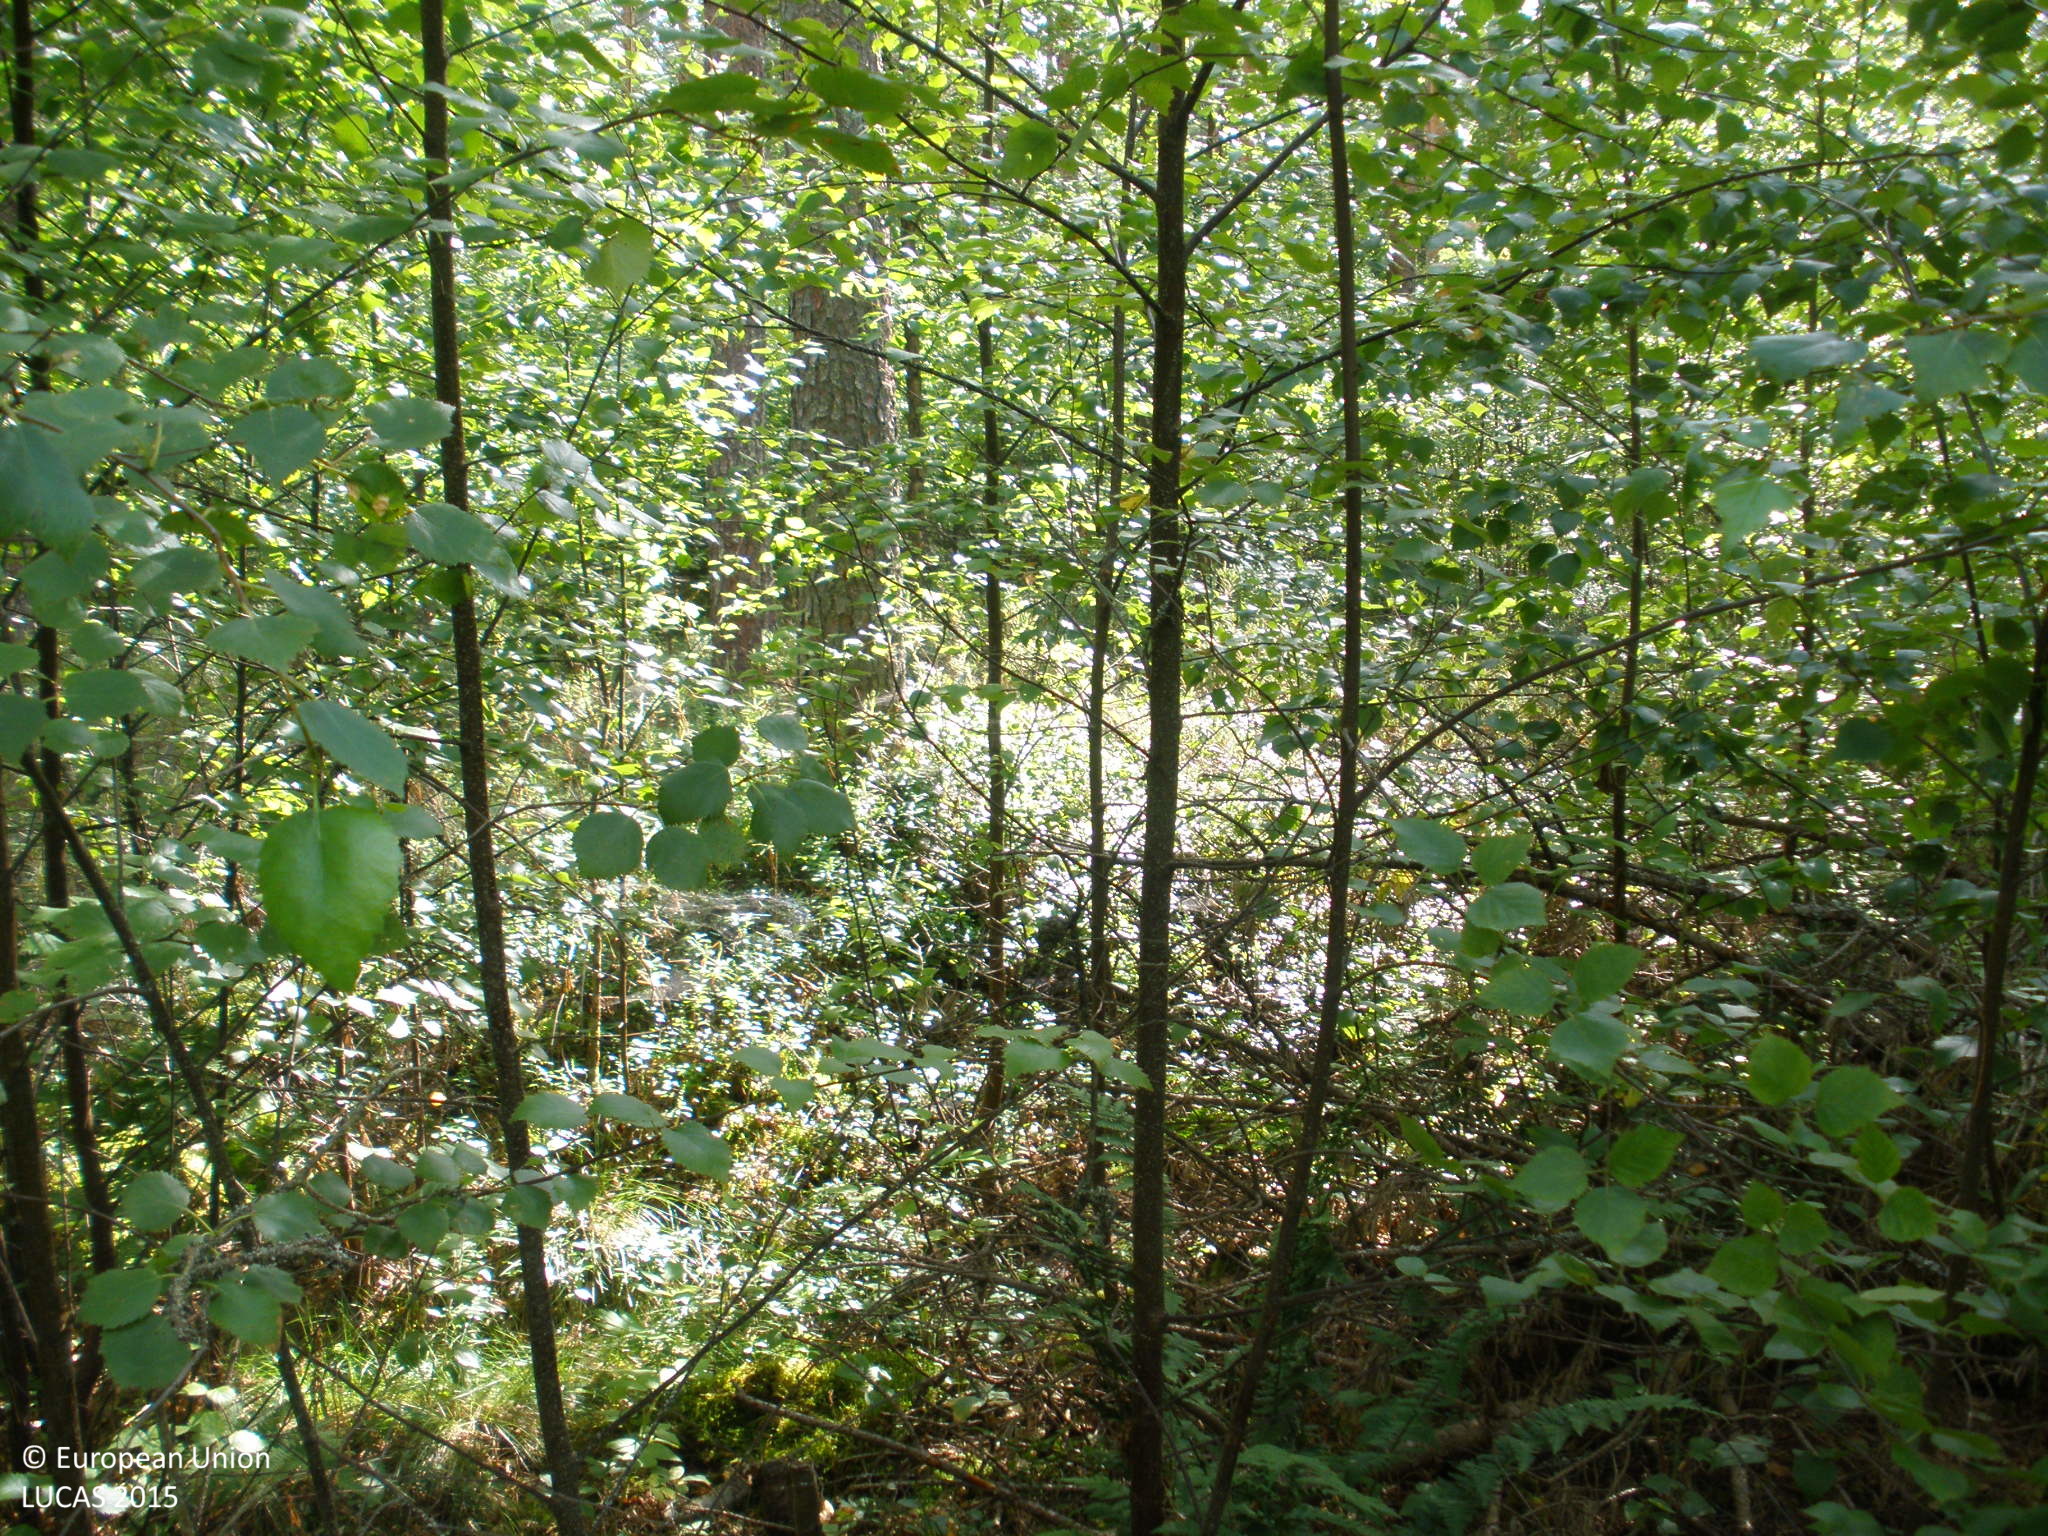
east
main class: Woodland
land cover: Pine dominated mixed woodland
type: boreal forest
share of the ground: > 75 %
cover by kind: coniferous forest trees 60 %, broadleaved forest trees 25 %, lichens and mosses 10 %, herbaceous plants 5 %
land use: Forestry
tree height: > 5 m
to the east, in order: Pine dominated mixed woodland; Ditches and canals; Pine dominated mixed woodland; Ditches and canals; Spruce dominated mixed woodland; Ditches and canals; Spontaneously vegetated surfaces; Ditches and canals; Grass margins; Paved roads, cycling and walking lanes; Spontaneously vegetated surfaces; Spruce dominated mixed woodland
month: July
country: FI
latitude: 61.1868
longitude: 25.0490
